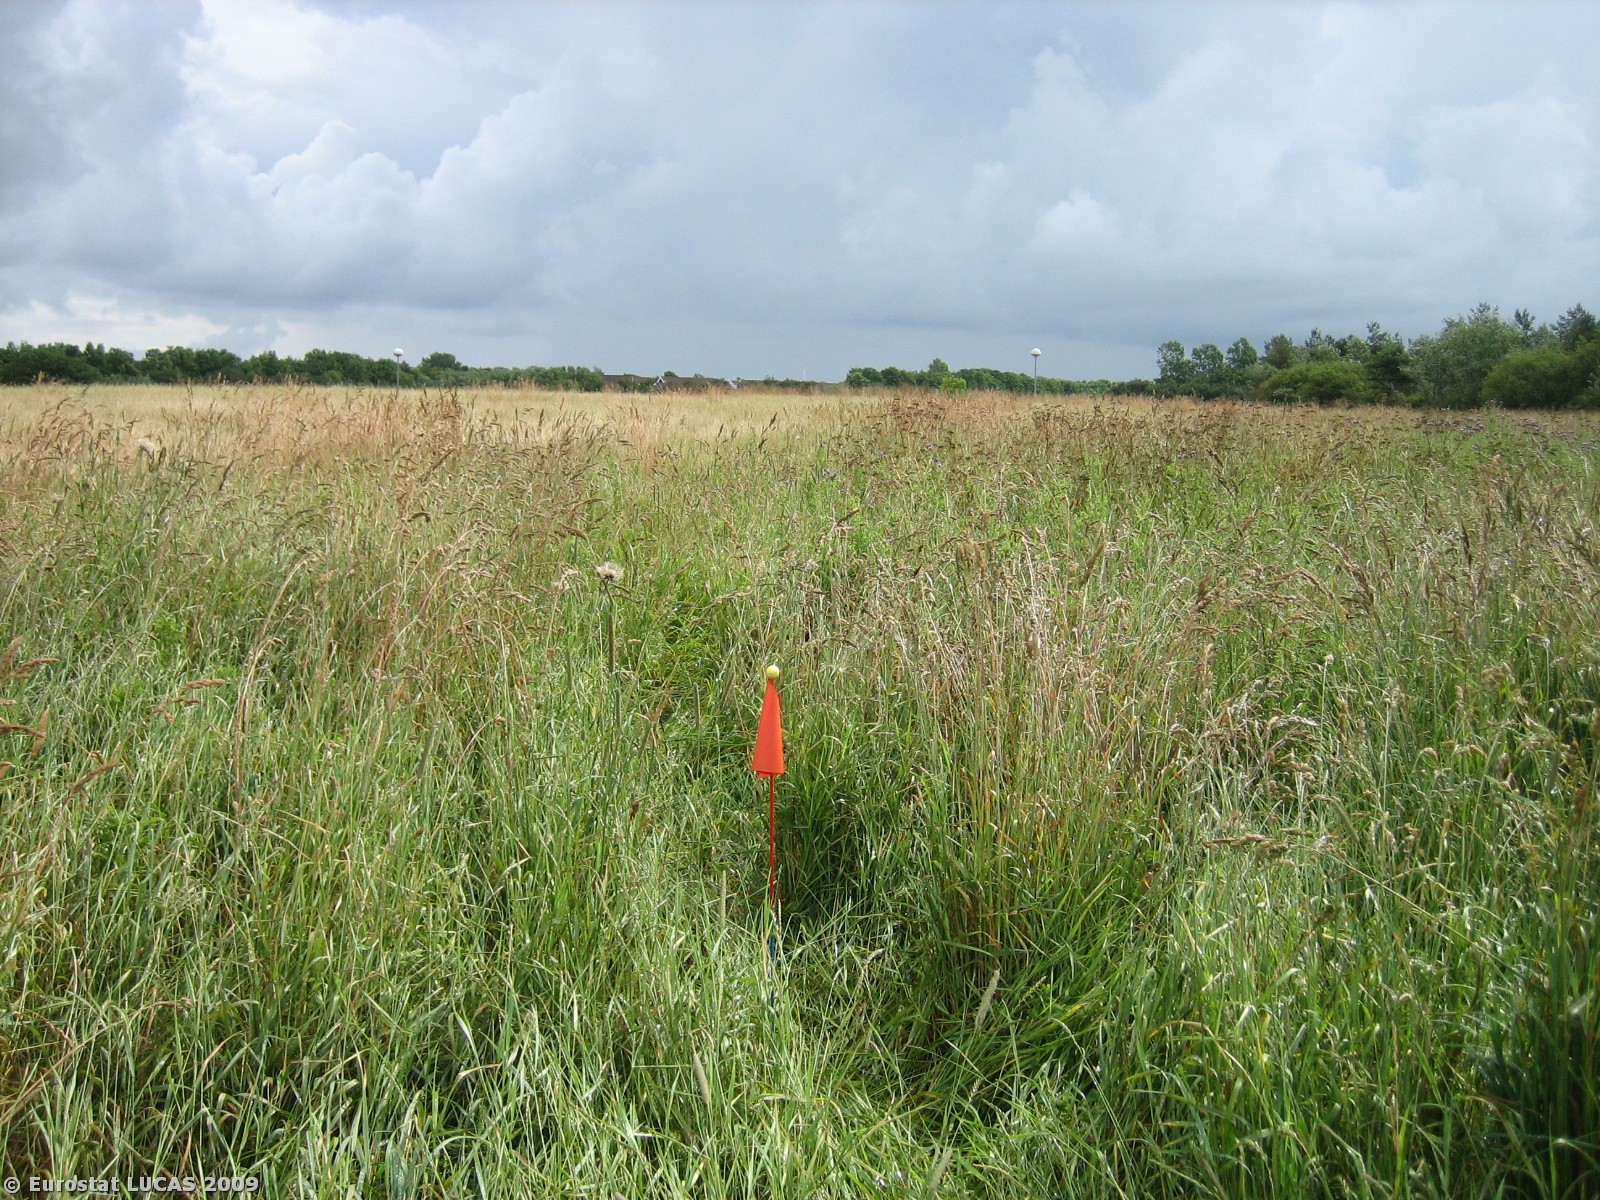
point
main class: Grassland
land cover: Grassland without tree/shrub cover
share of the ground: > 75 %
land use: Amenities, museums, leisure
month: July
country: DK
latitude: 55.5130
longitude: 8.4336
